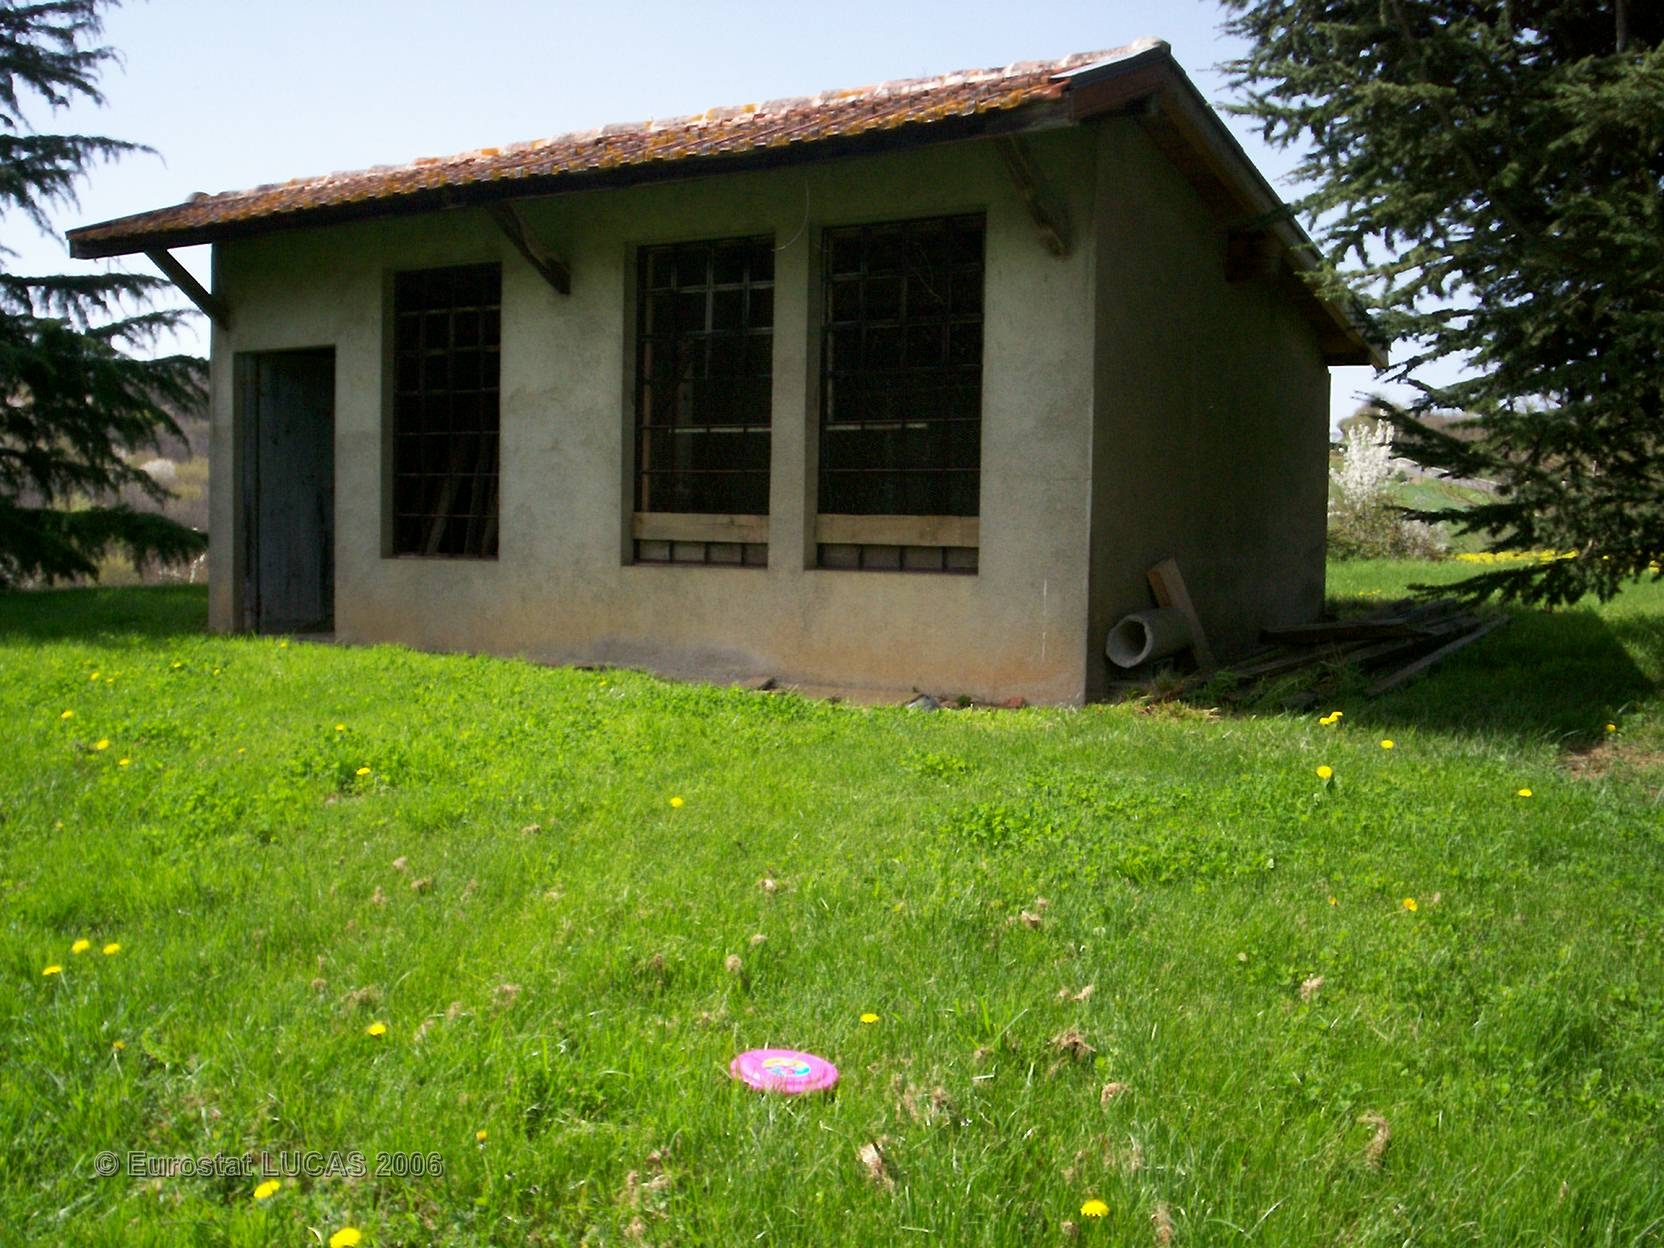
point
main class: Grassland
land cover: Grassland with sparse tree/shrub cover
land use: Residential
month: April
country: FR
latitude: 43.4184
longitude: 0.2521
